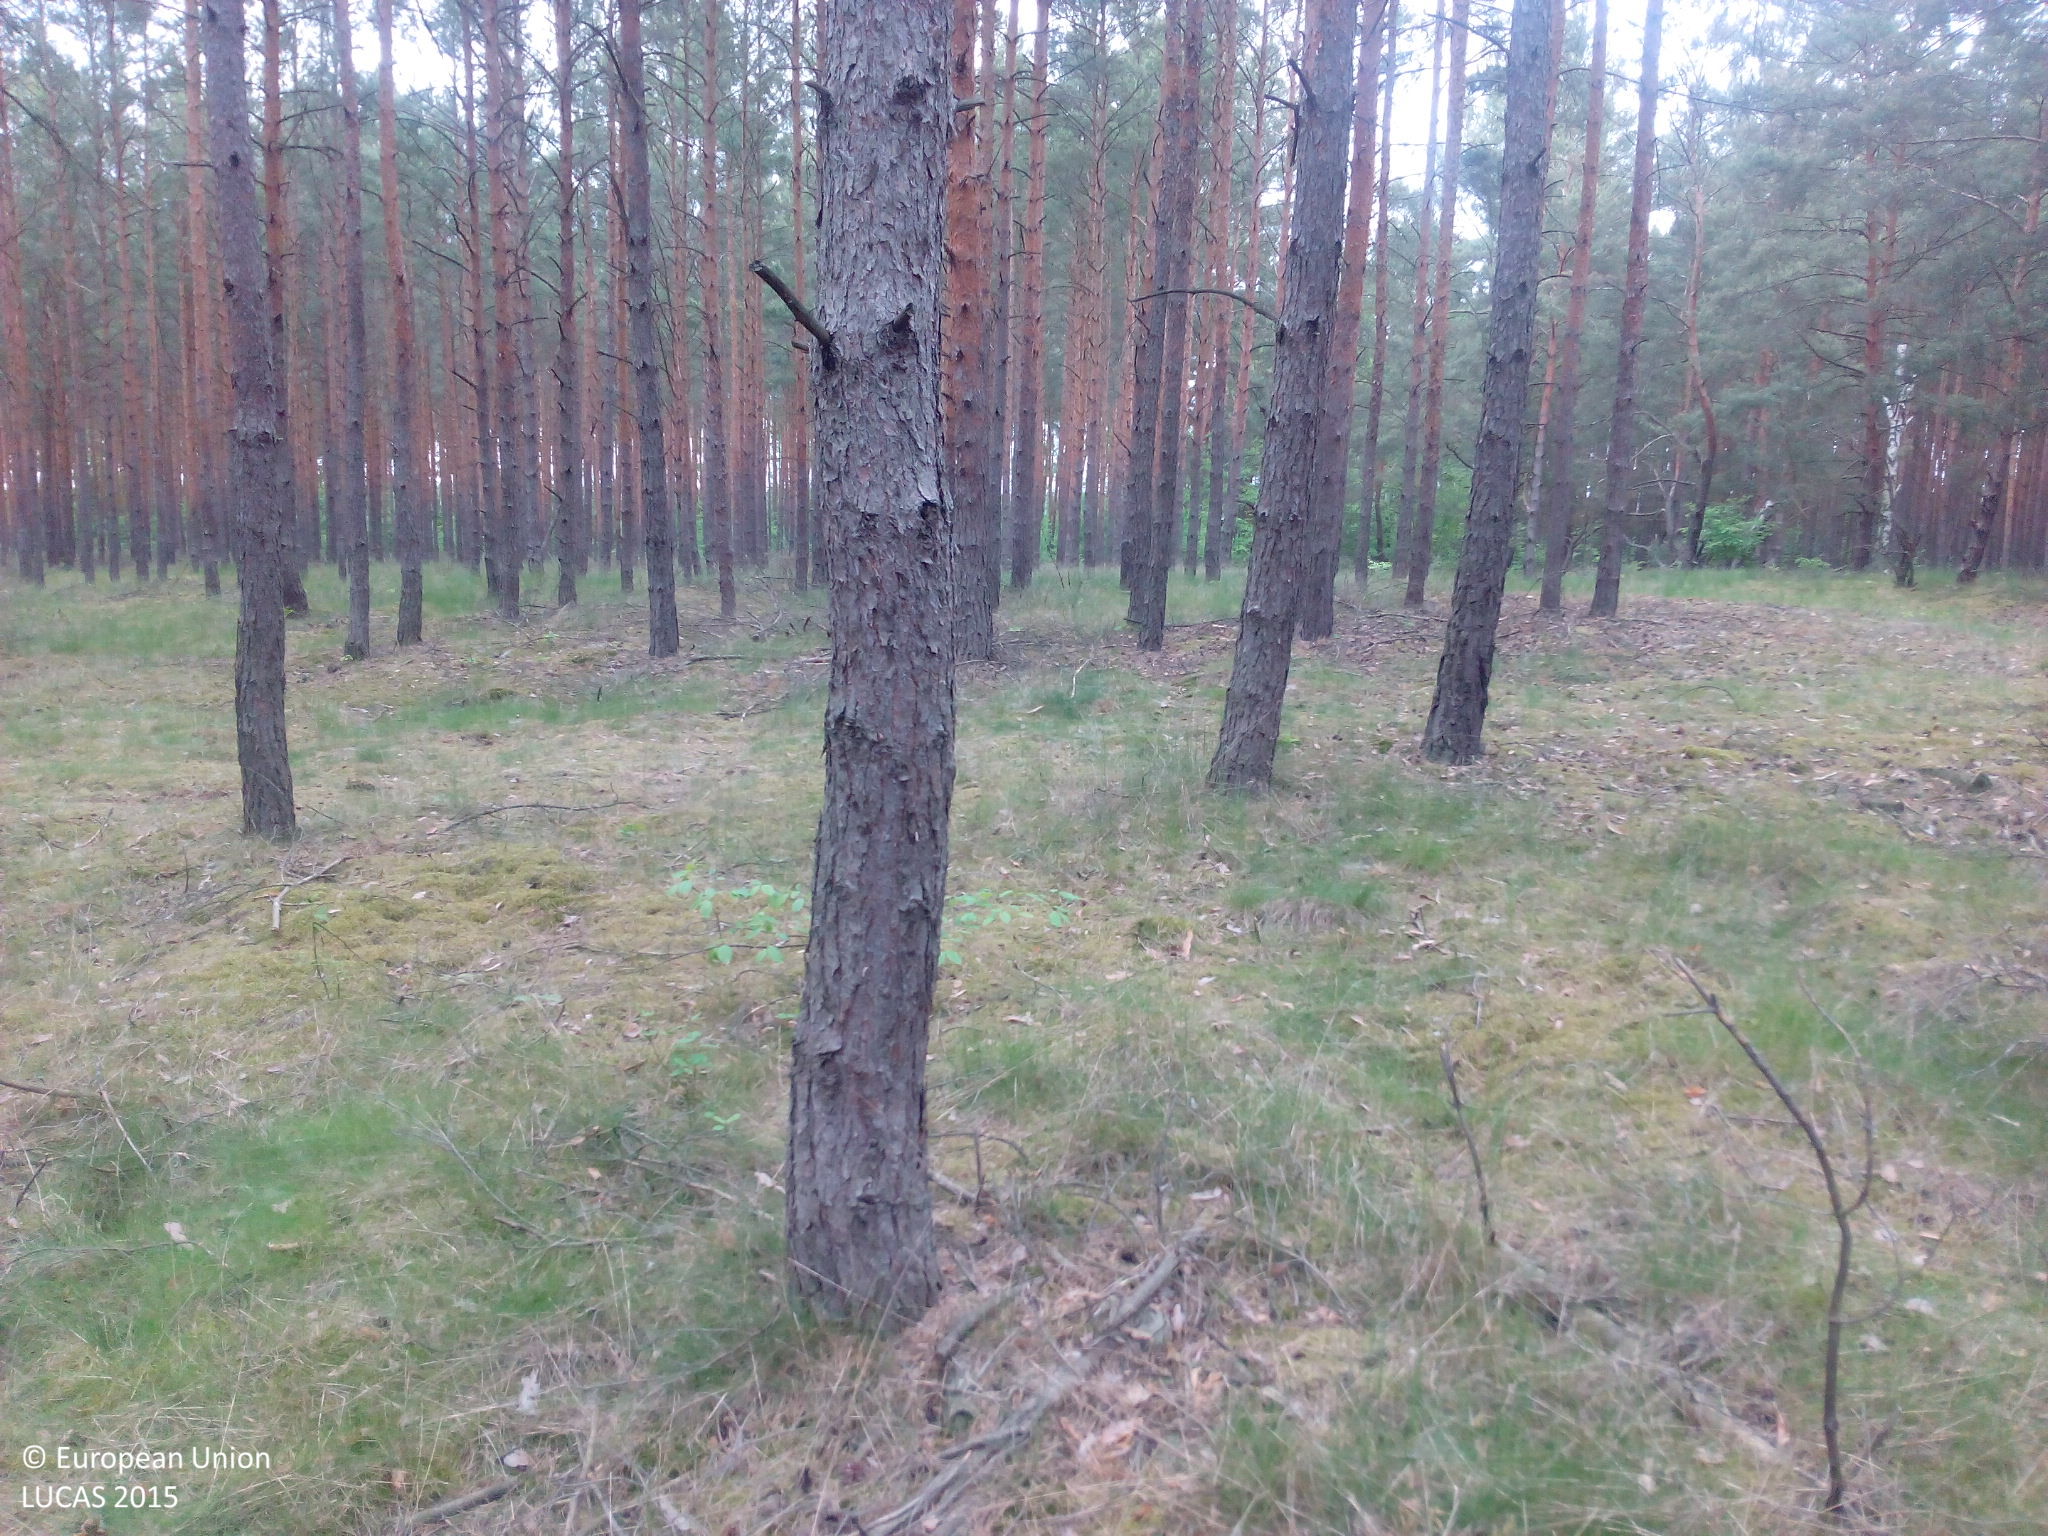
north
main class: Woodland
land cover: Pine dominated coniferous woodland
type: hemiboreal forest and nemoral coniferous forest and mixed broadleaved-coniferous forest
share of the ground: > 75 %
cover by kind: coniferous forest trees 75 %, lichens and mosses 20 %, herbaceous plants 5 %
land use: Forestry
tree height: > 5 m
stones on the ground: < 10 %
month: May
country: DE
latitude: 52.2271
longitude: 13.1769
